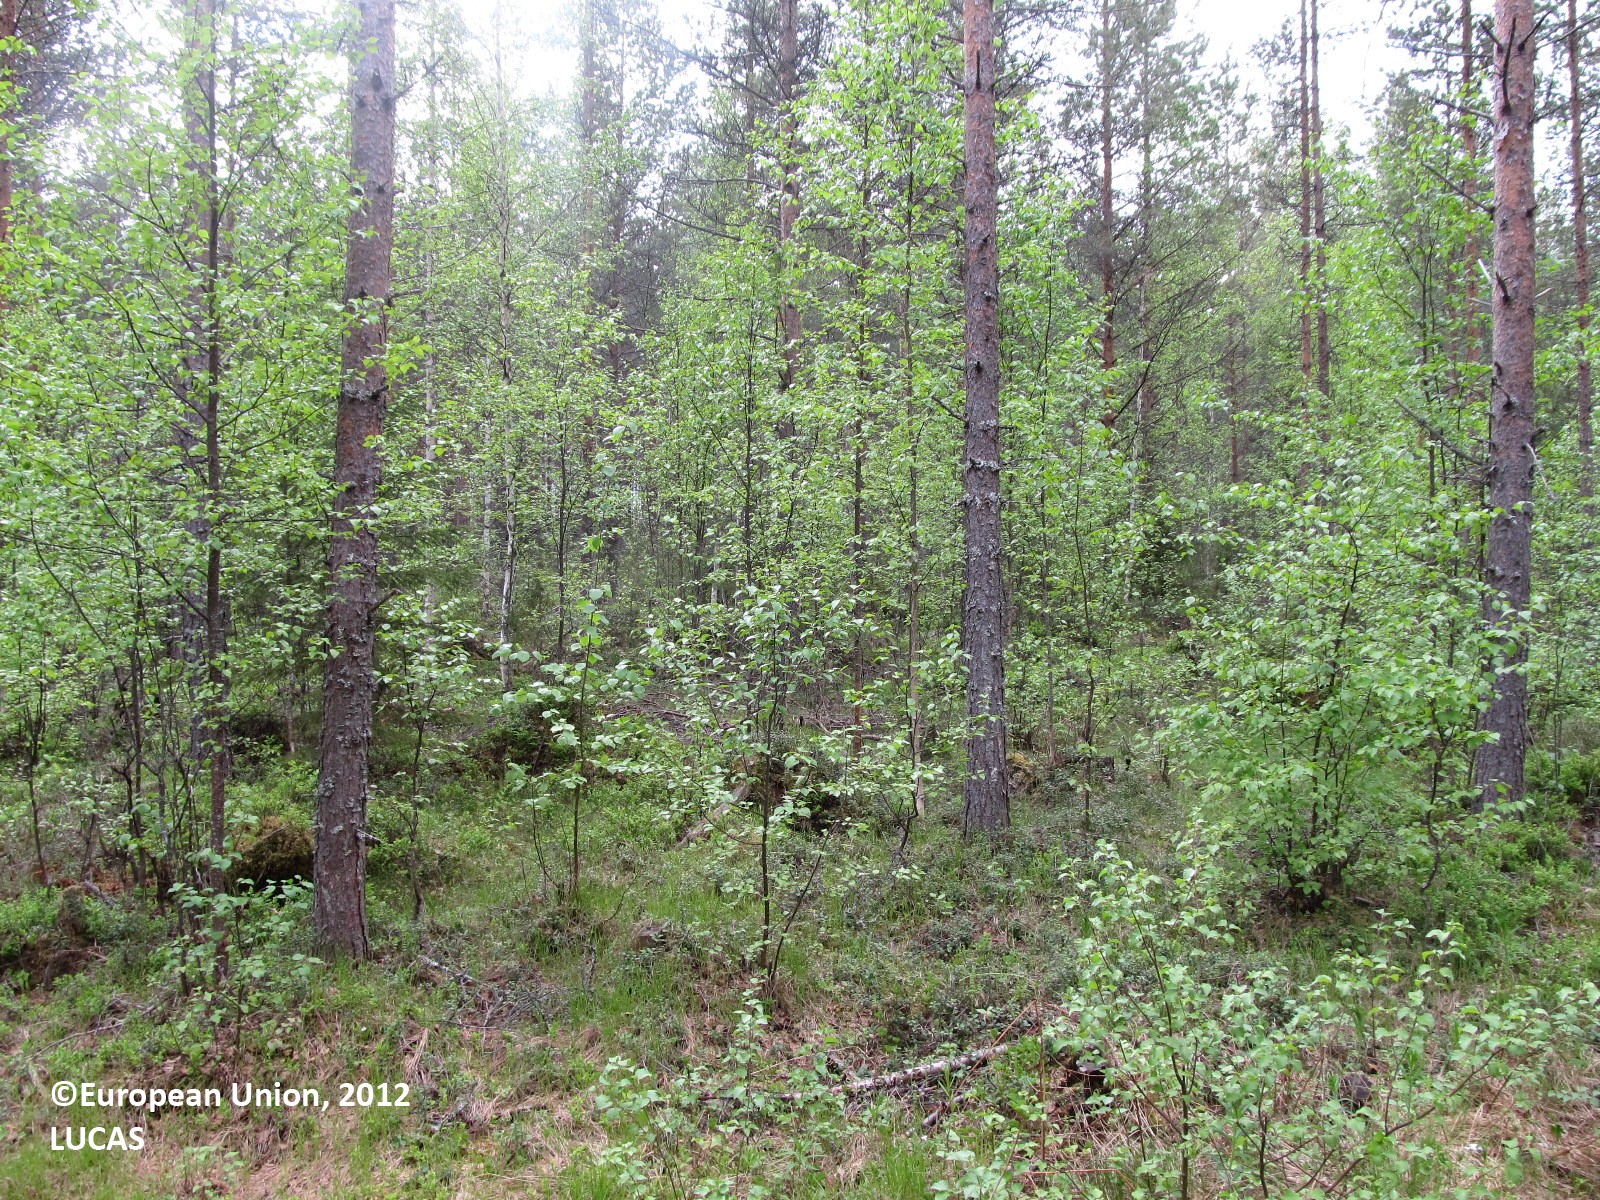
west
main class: Woodland
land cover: Pine dominated mixed woodland
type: boreal forest
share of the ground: 25 - 50 %
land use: Forestry
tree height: > 5 m
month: June
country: FI
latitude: 63.2274
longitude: 29.1814
